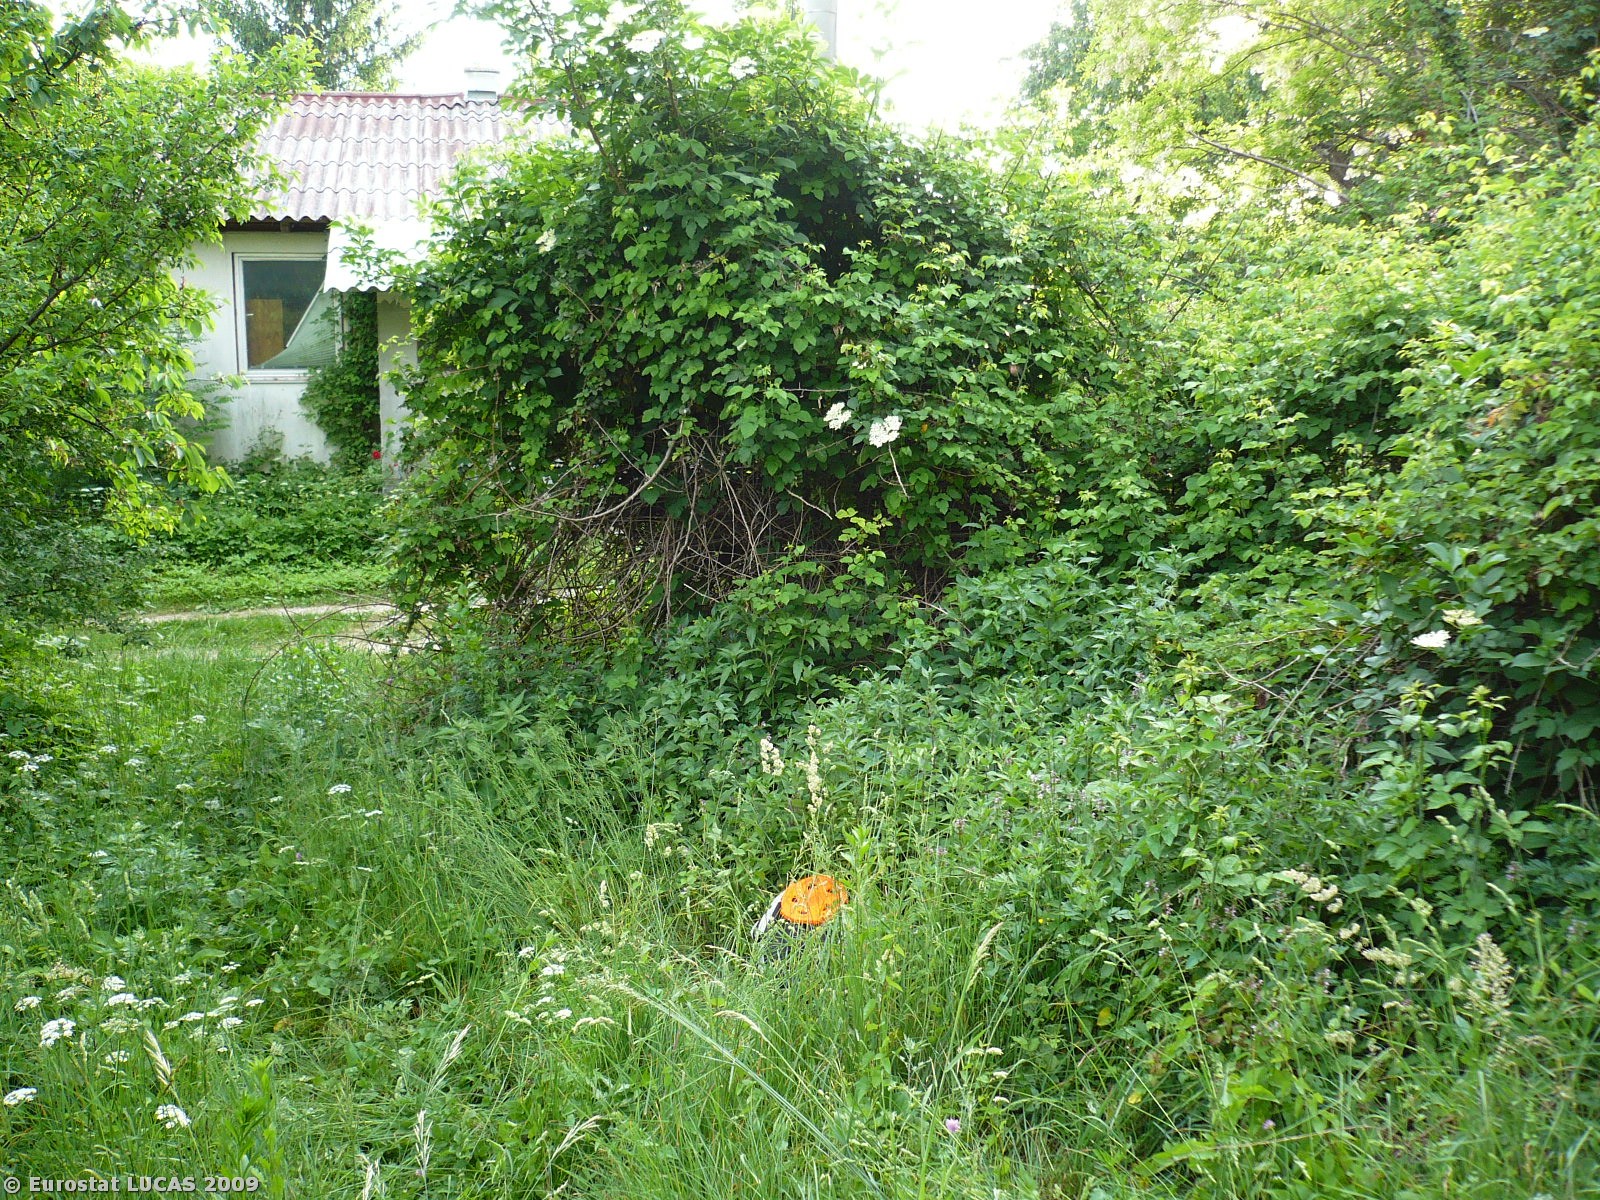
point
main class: Shrubland
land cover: Shrubland with sparse tree cover
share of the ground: 25 - 50 %
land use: Unused
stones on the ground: < 10 %
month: May
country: SI
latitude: 45.9636
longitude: 13.6738
